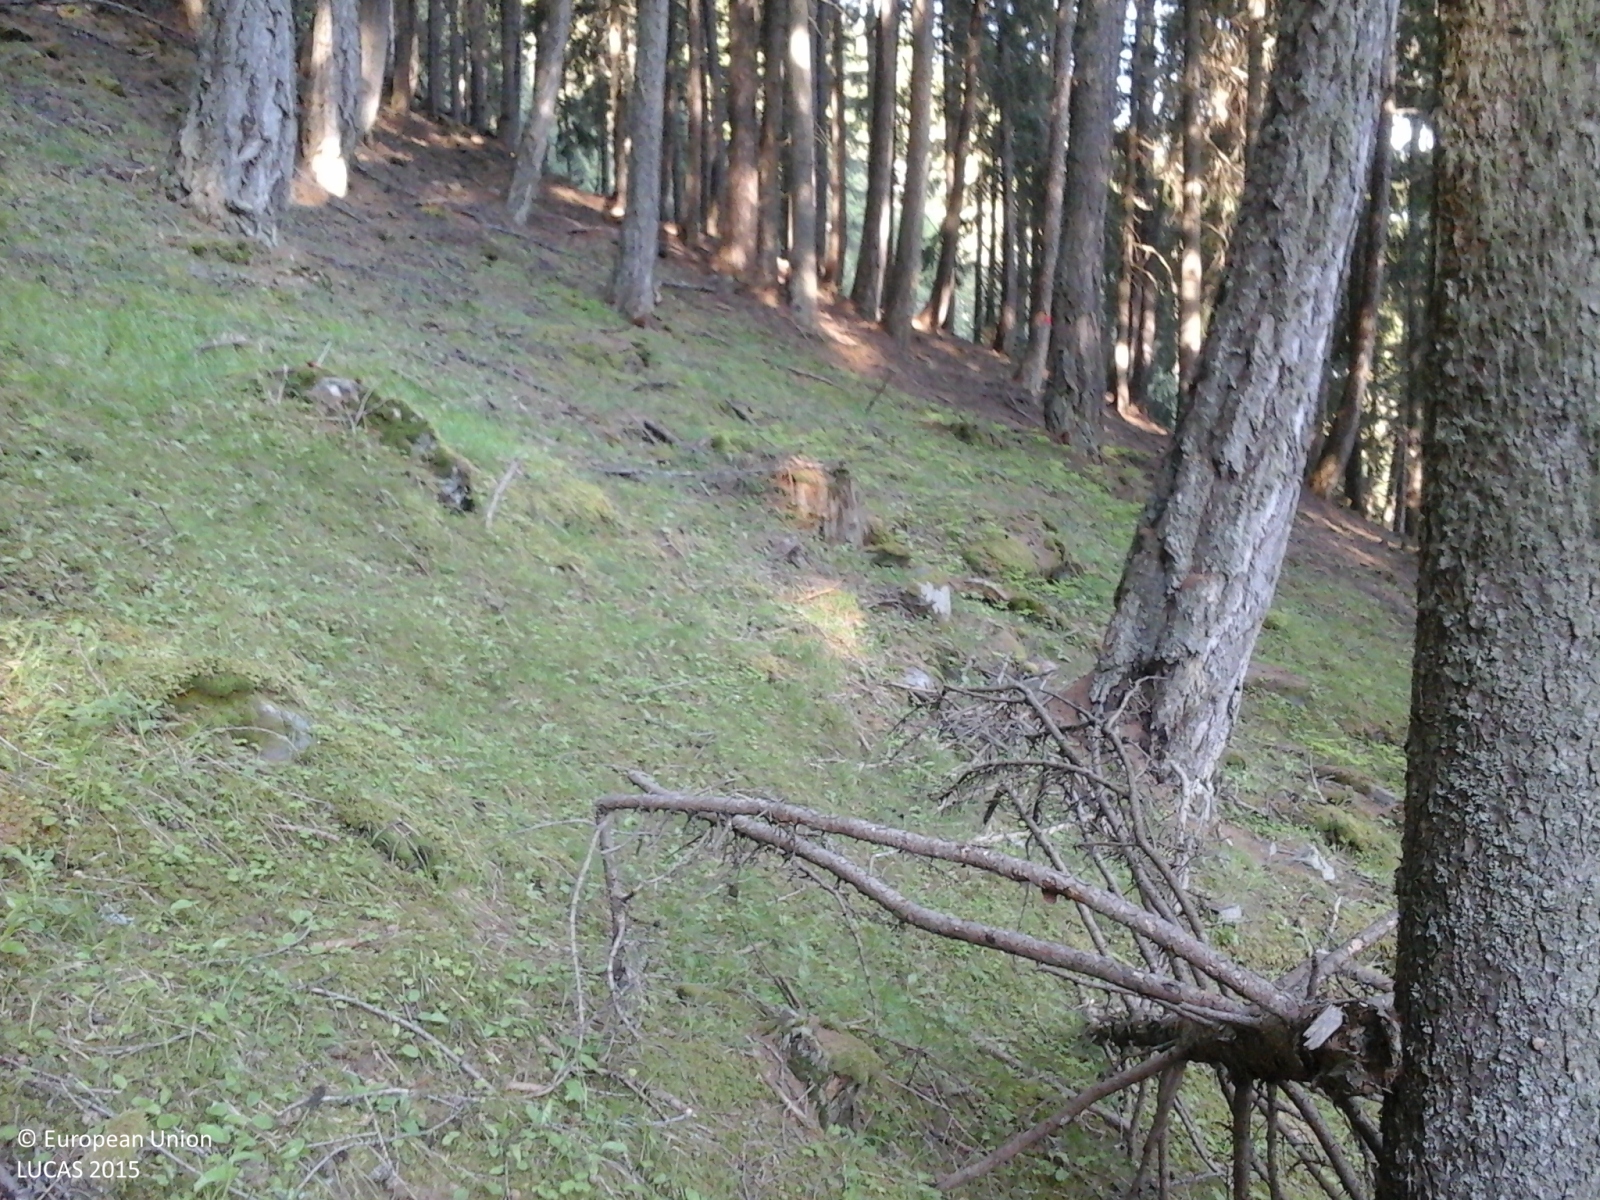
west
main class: Woodland
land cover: Spruce dominated coniferous woodland
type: alpine coniferous forest
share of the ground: > 75 %
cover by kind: coniferous forest trees 100 %
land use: Forestry
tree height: > 5 m
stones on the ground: 10 - 25 %
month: May
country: IT
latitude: 46.6010
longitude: 10.7171
